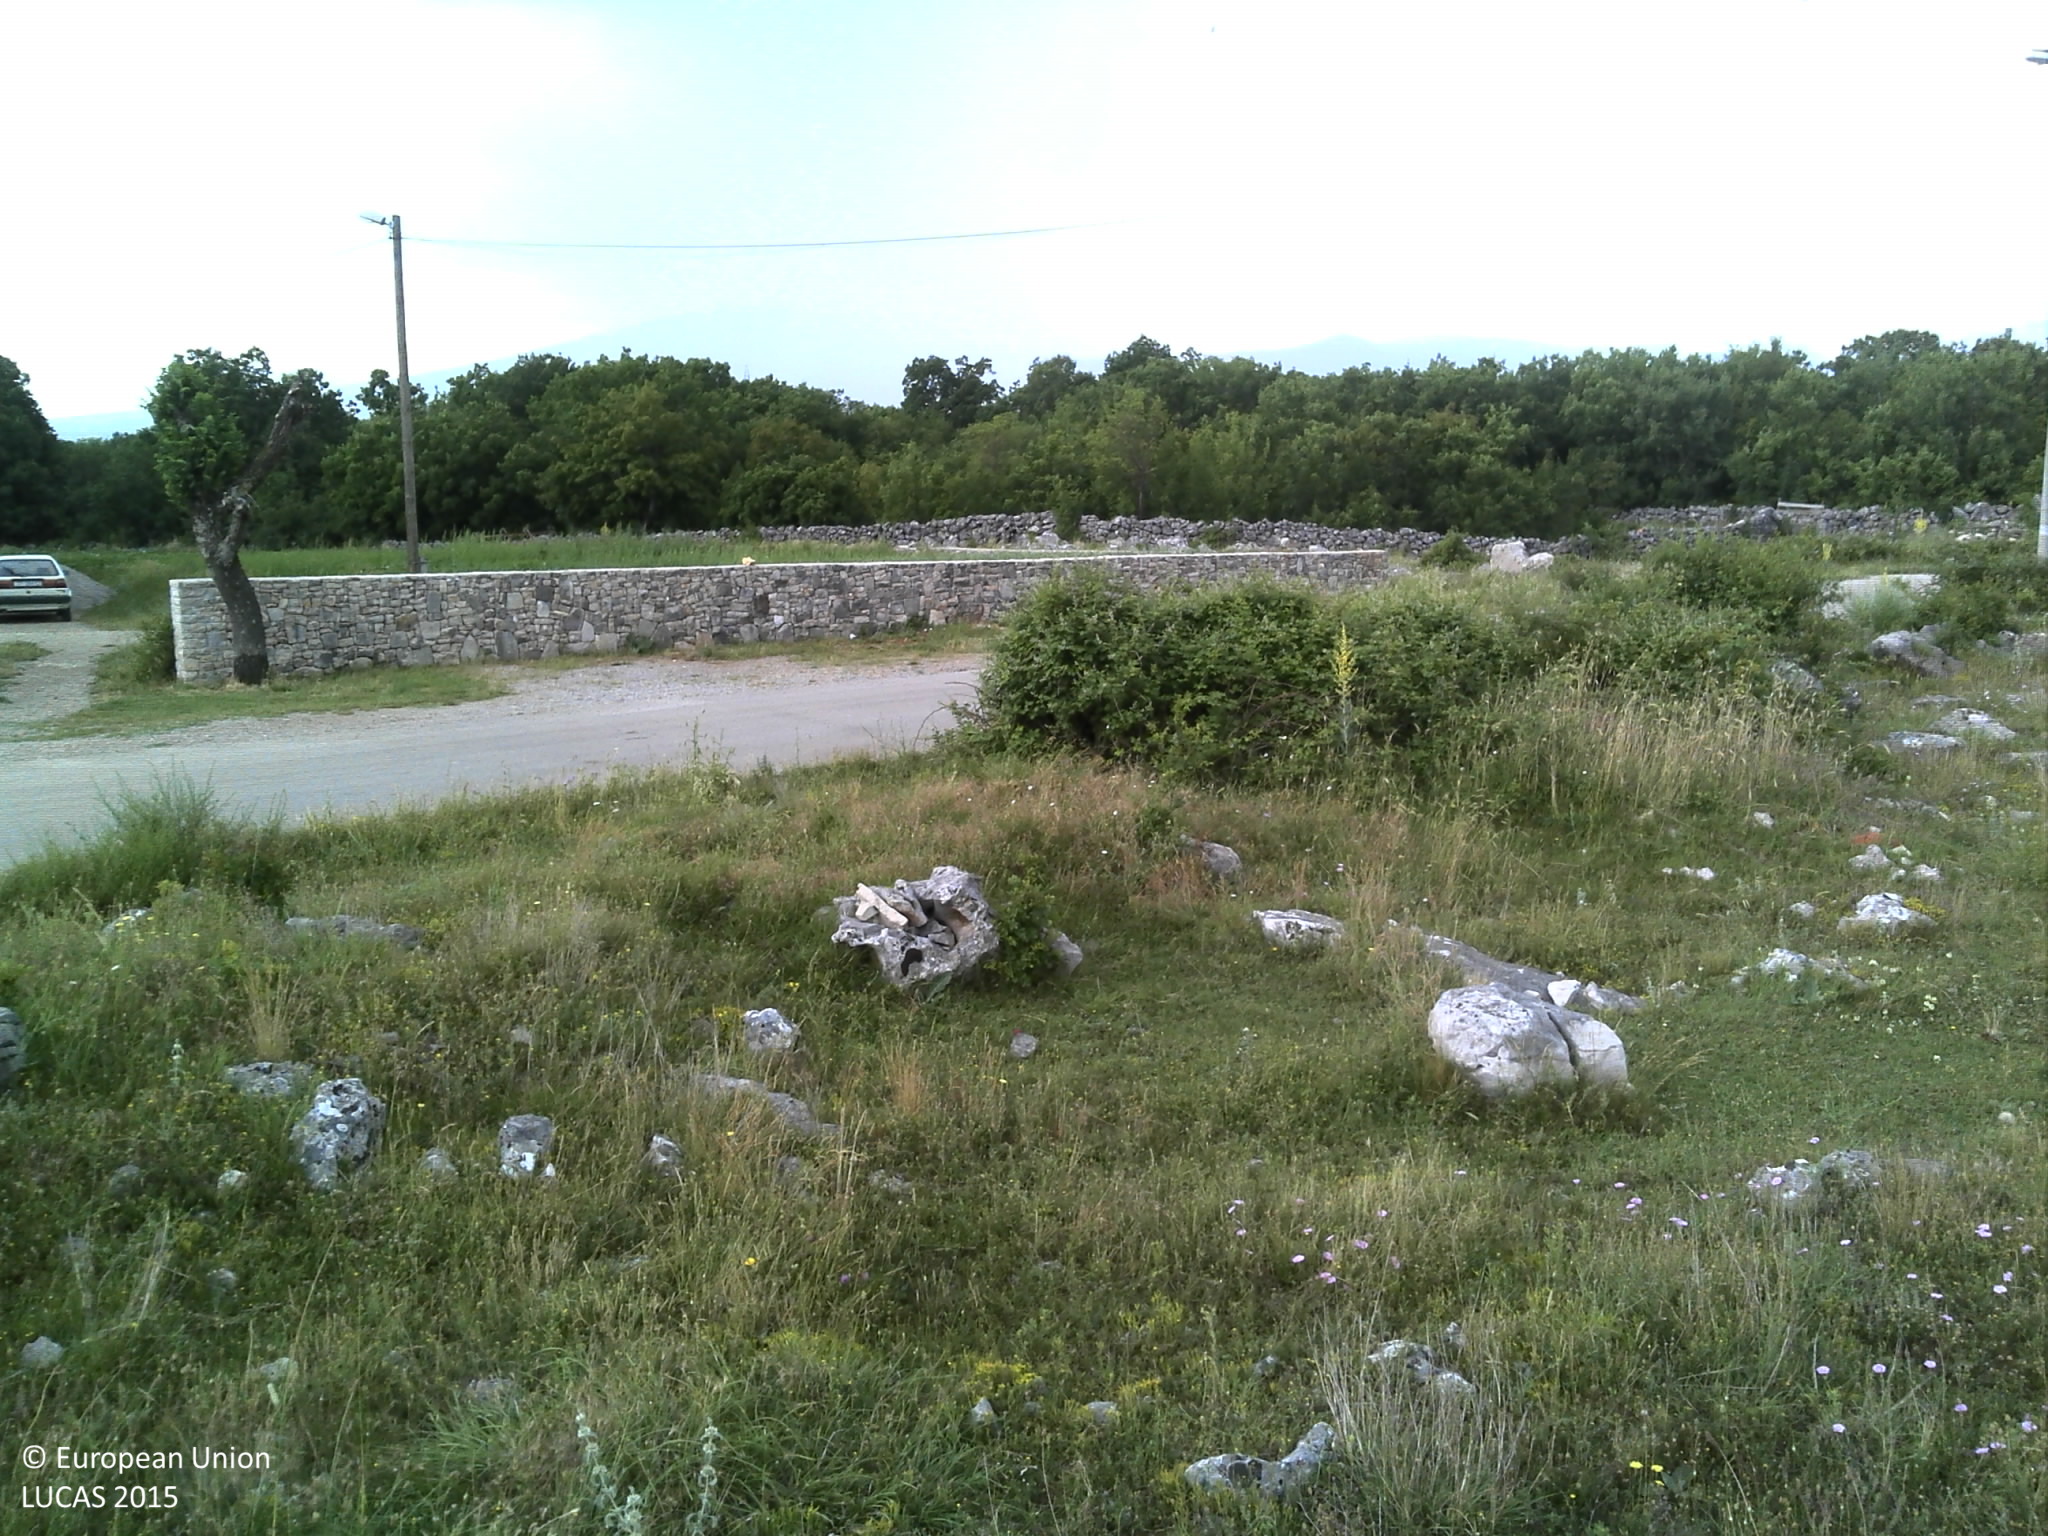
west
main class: Grassland
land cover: Grassland with sparse tree/shrub cover
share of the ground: 50 - 75 %
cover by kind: herbaceous plants 65 %, unconsolidated bare surface 20 %, broadleaved forest trees 5 %, shrubs 5 %, consolidated bare surface 5 %
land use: Abandoned areas
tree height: > 5 m
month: June
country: HR
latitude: 43.7955
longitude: 16.6165
